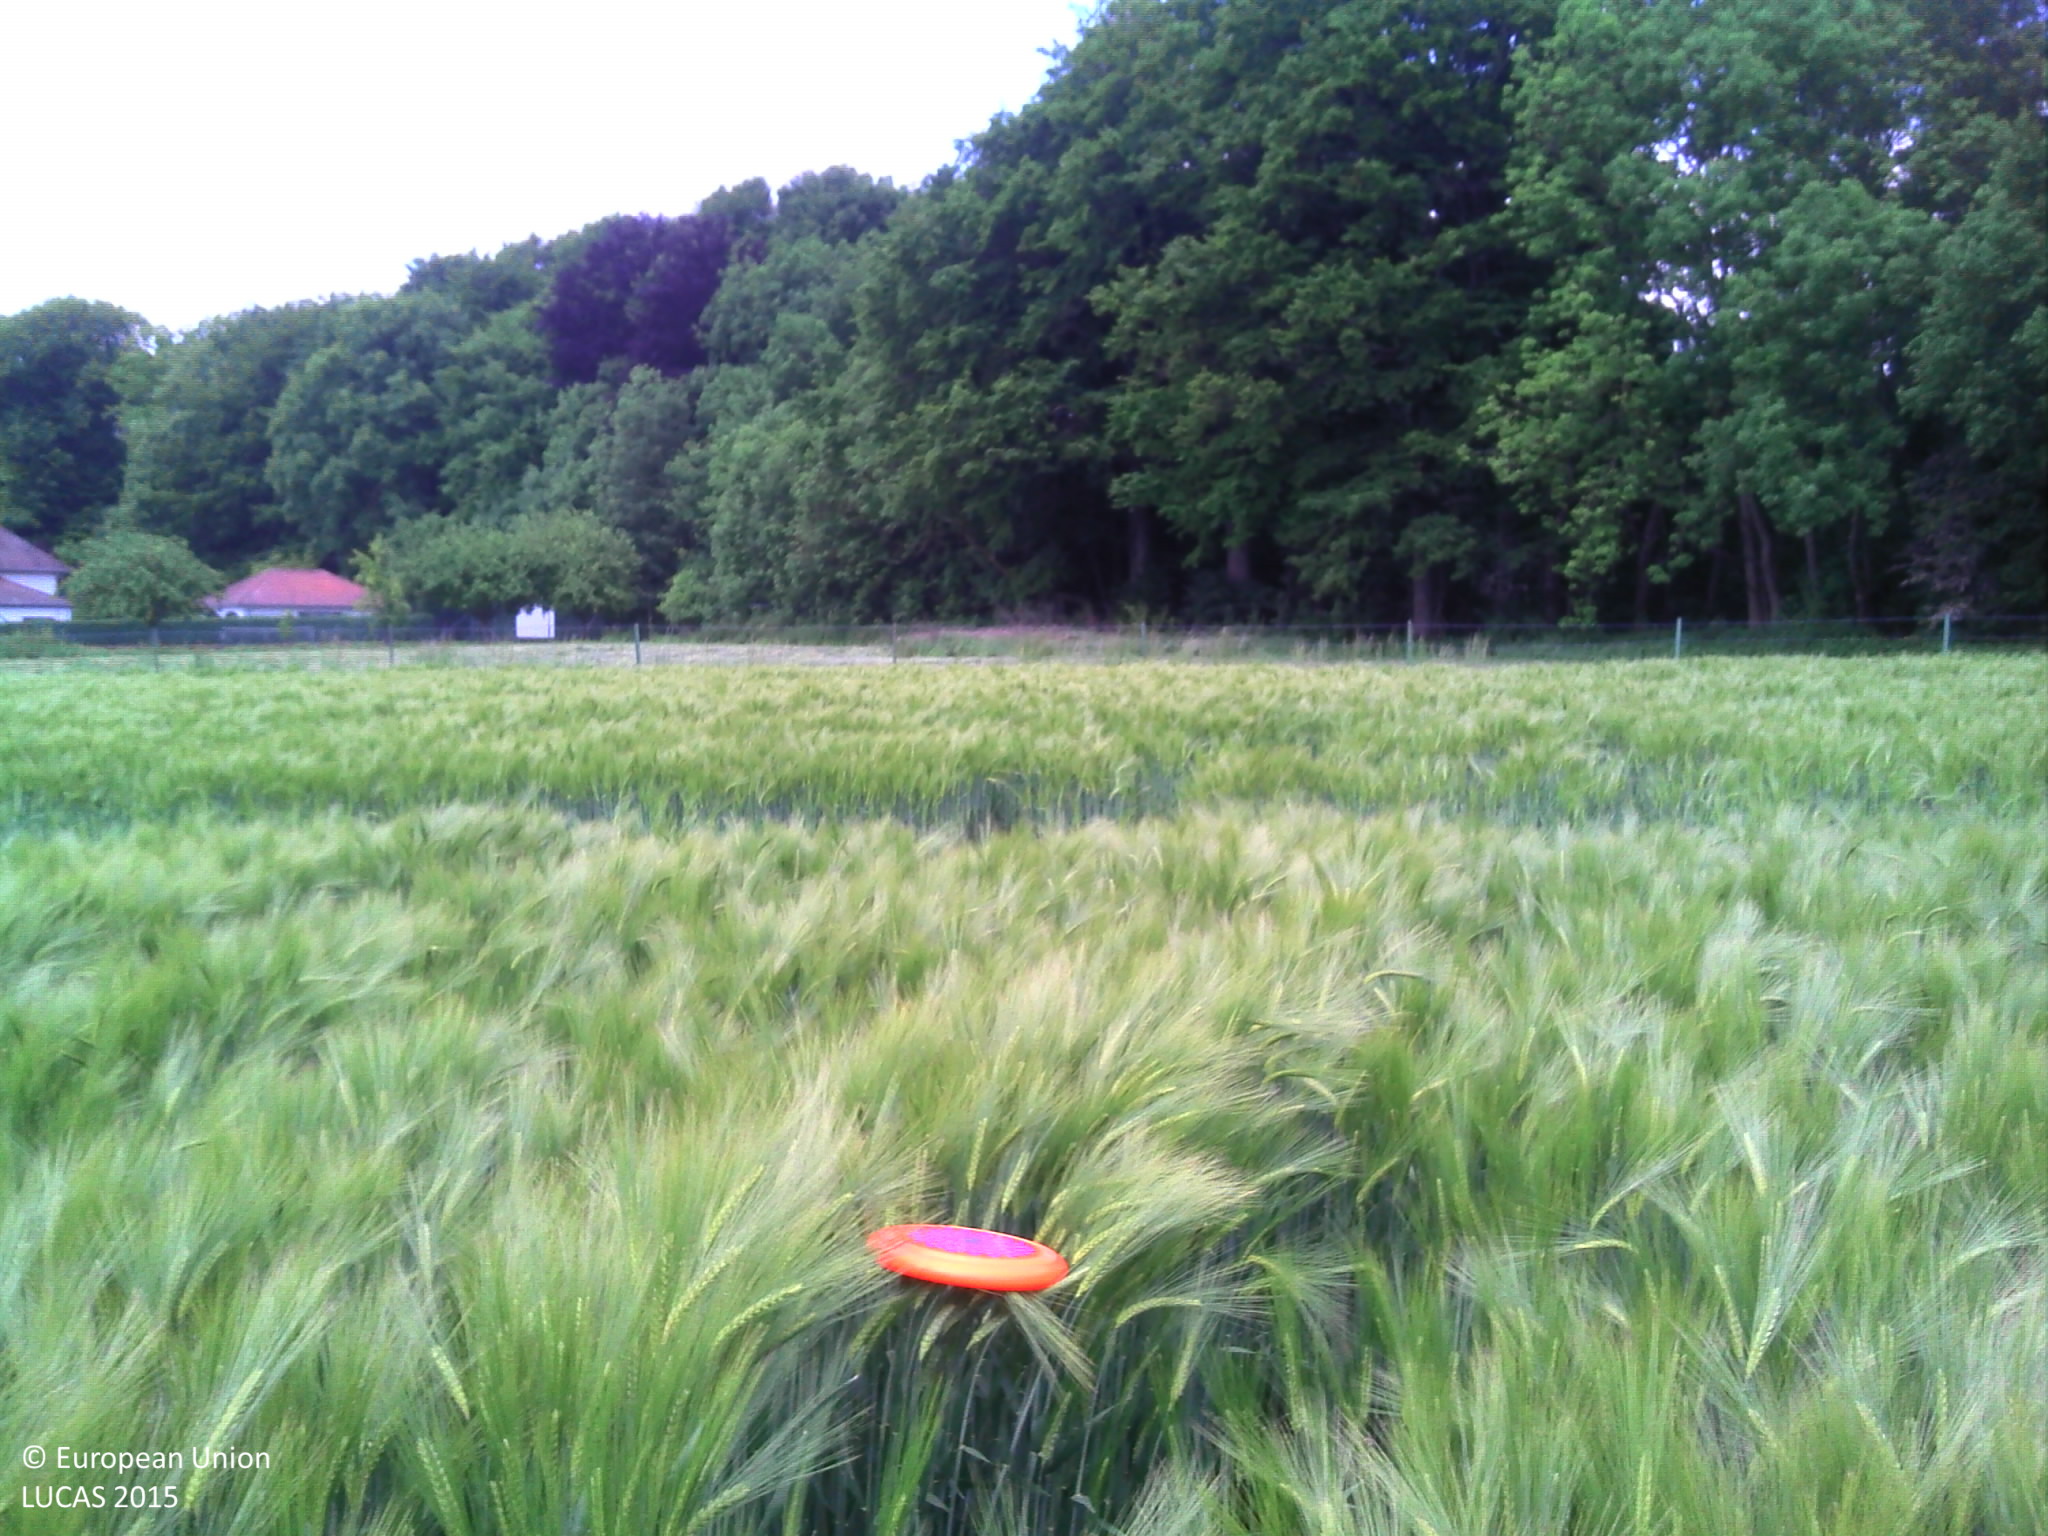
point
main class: Cropland
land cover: Barley
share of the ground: > 75 %
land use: Agriculture (excluding fallow land and kitchen gardens)
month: May
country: BE
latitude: 50.5372
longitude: 4.4790
